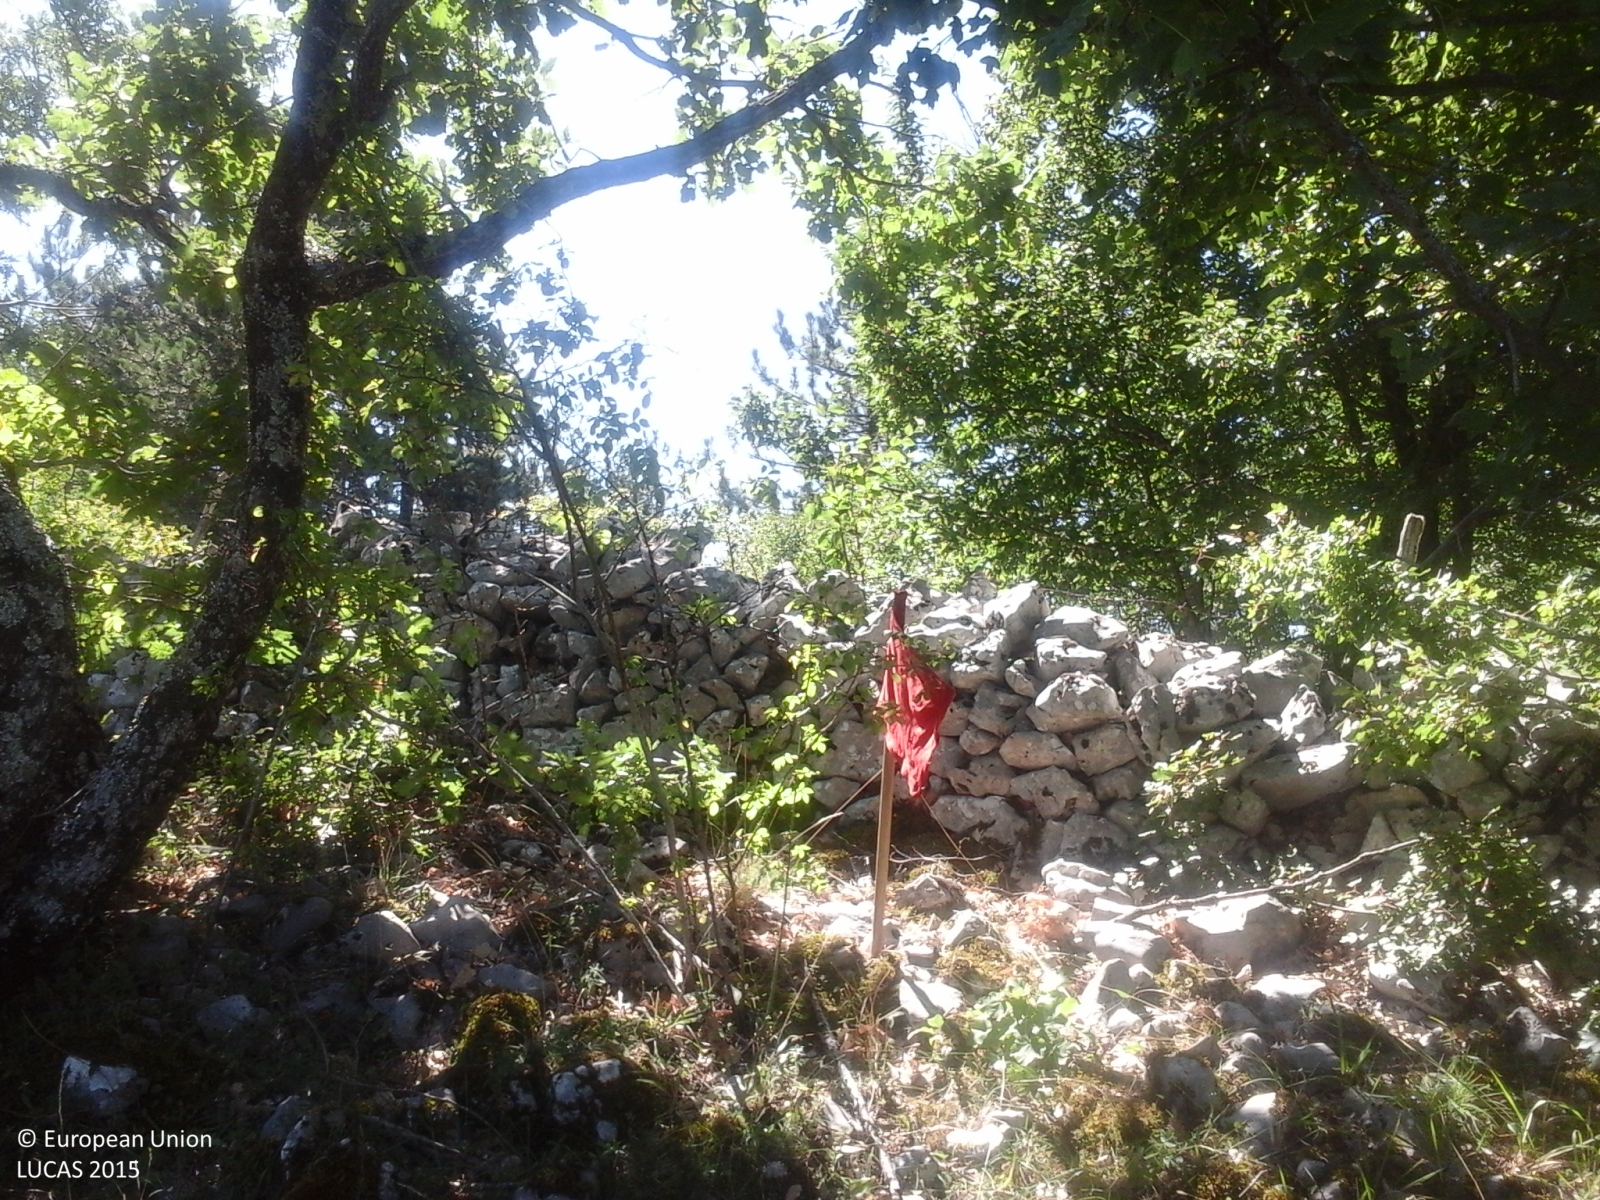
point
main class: Woodland
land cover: Broadleaved woodland
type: thermophilous deciduous forest
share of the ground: 50 - 75 %
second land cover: Grassland without tree/shrub cover
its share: > 75 %
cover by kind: broadleaved forest trees 100 %
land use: Forestry
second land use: Agriculture (excluding fallow land and kitchen gardens)
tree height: < 5 m
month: August
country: IT
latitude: 41.8989
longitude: 13.1828
